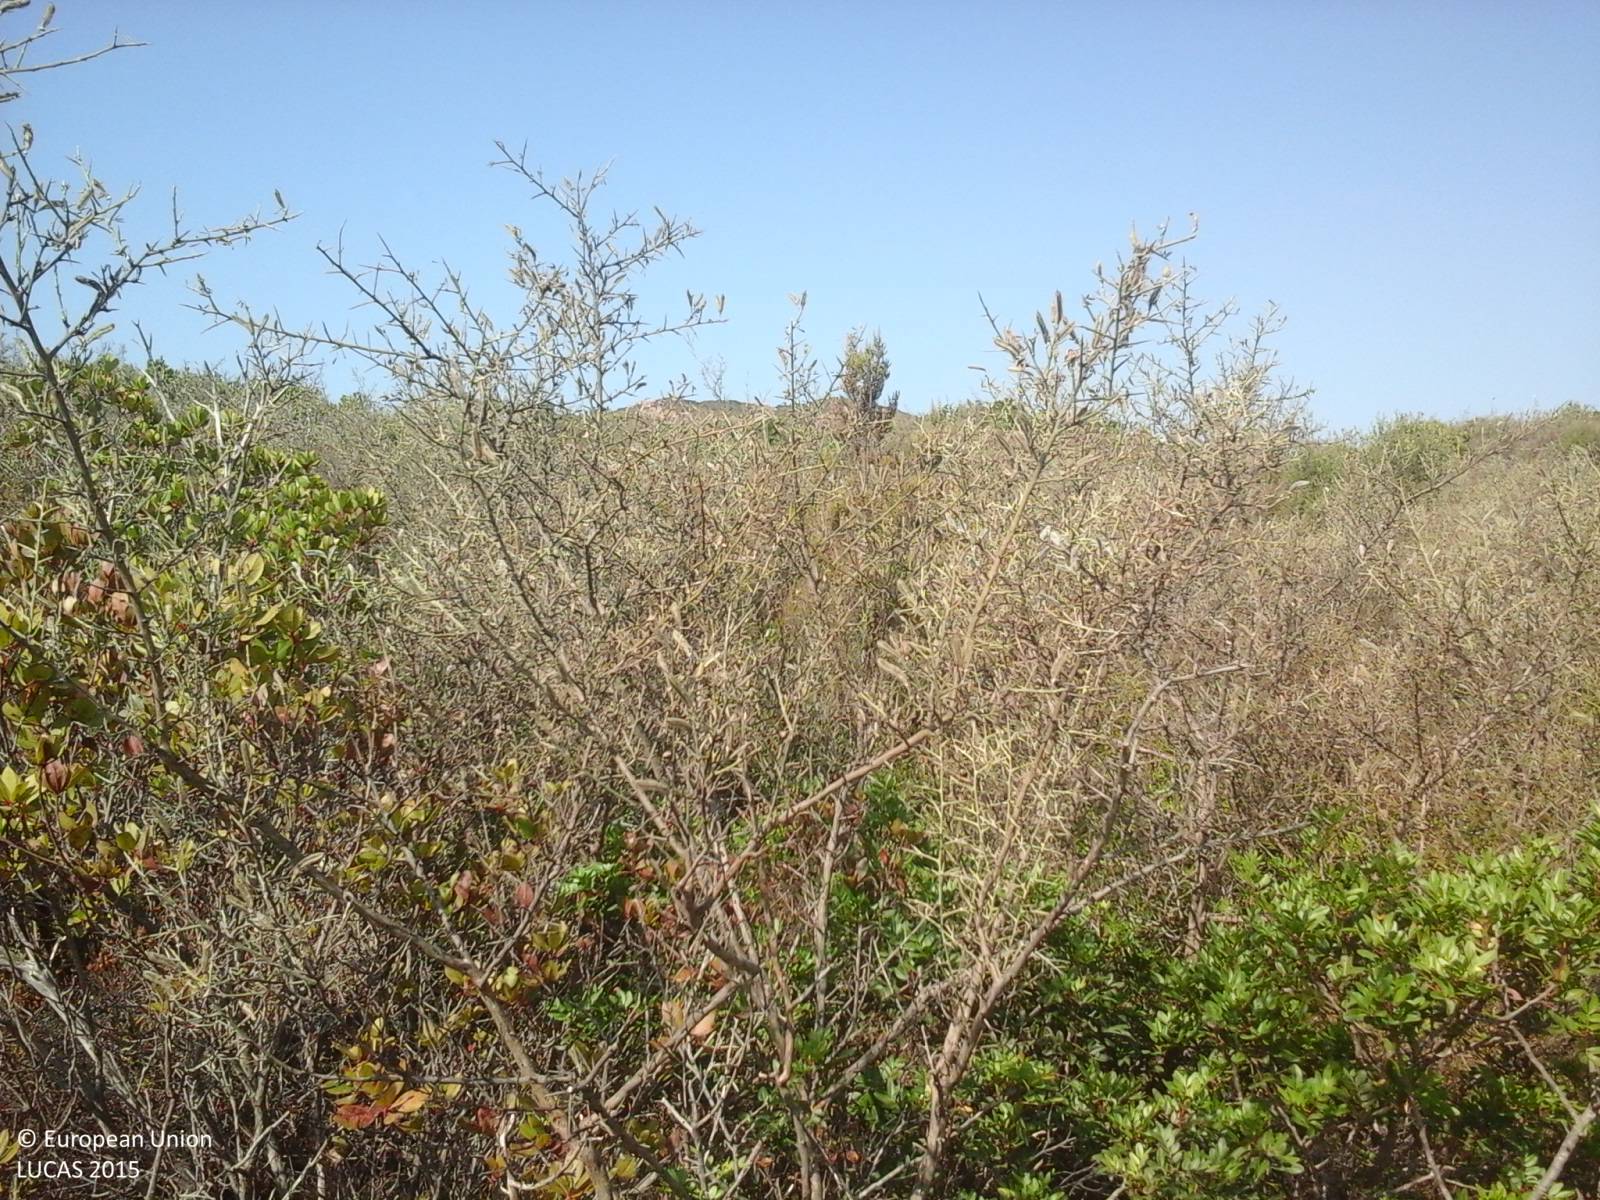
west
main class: Shrubland
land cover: Shrubland without tree cover
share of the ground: > 75 %
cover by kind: shrubs 95 %, unconsolidated bare surface 5 %
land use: Semi-natural and natural areas not in use
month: July
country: IT
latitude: 40.8638
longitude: 9.6340
